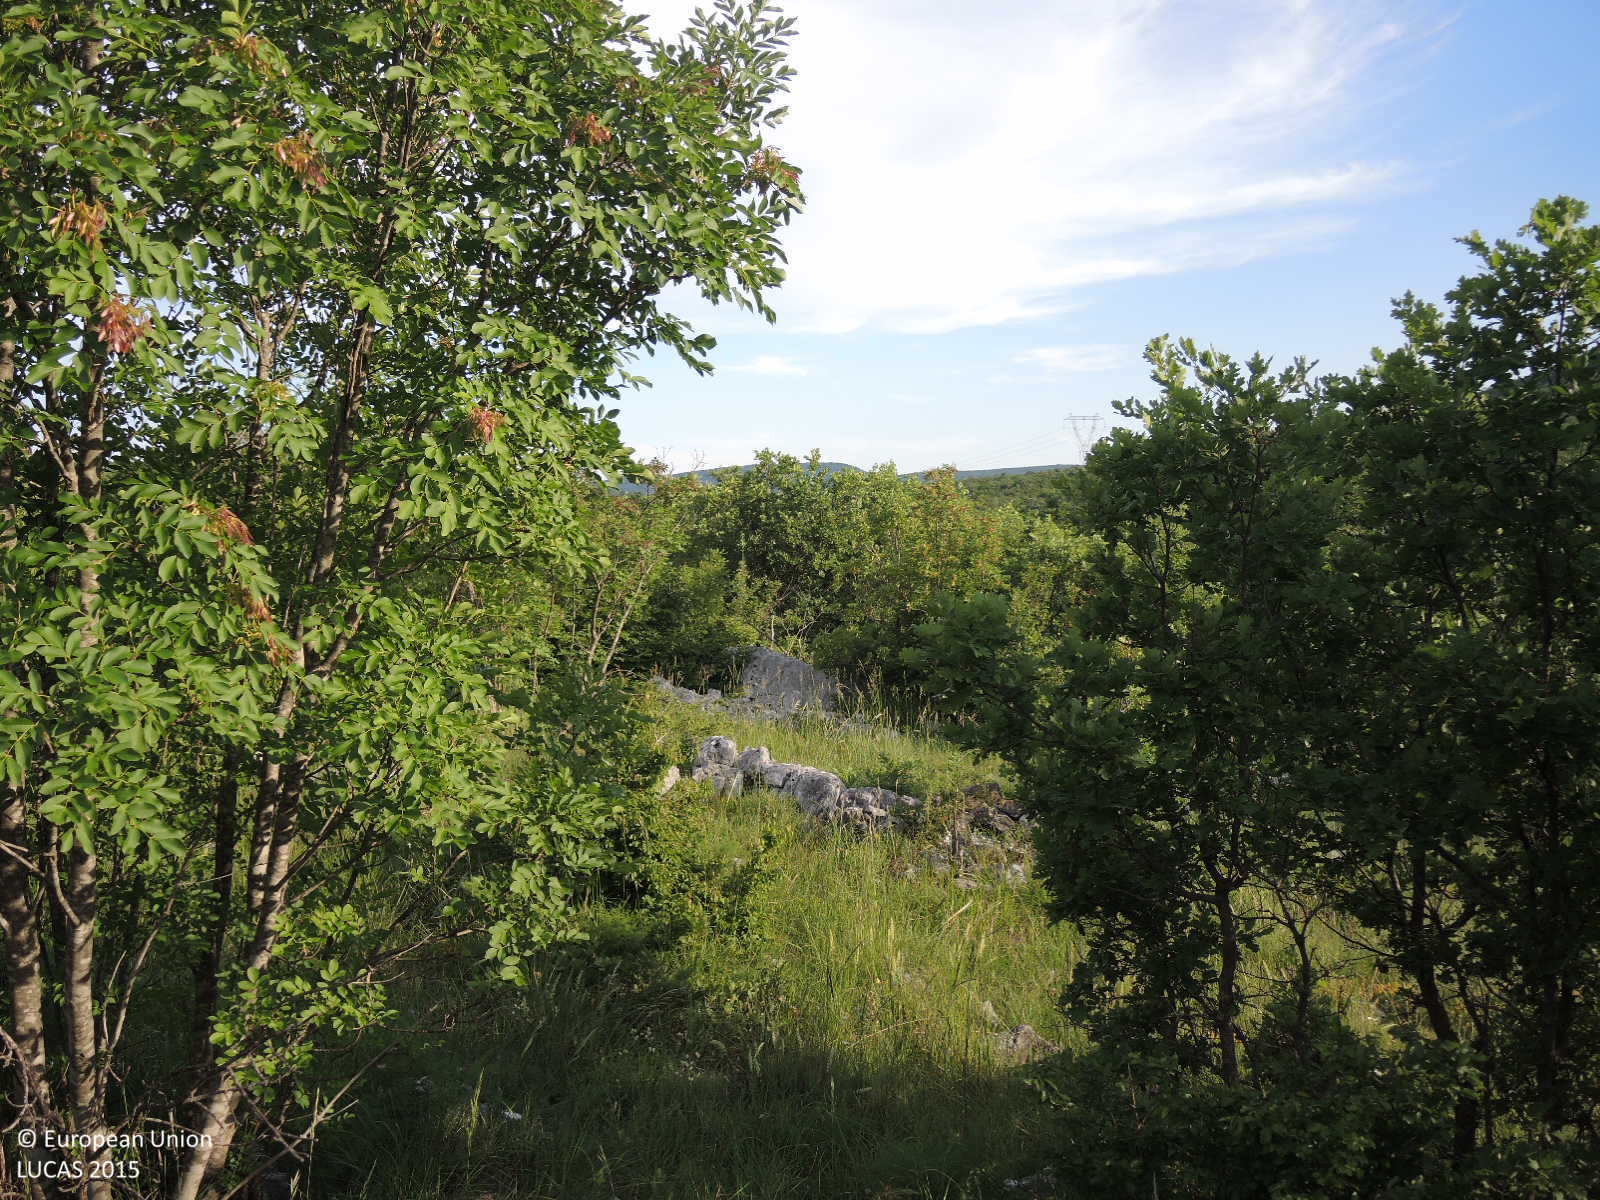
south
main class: Woodland
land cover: Broadleaved woodland
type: thermophilous deciduous forest
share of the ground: 50 - 75 %
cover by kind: broadleaved forest trees 50 %, herbaceous plants 15 %, consolidated bare surface 15 %, shrubs 10 %, unconsolidated bare surface 10 %
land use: Semi-natural and natural areas not in use
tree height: > 5 m
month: June
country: HR
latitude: 43.6884
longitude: 16.3060
